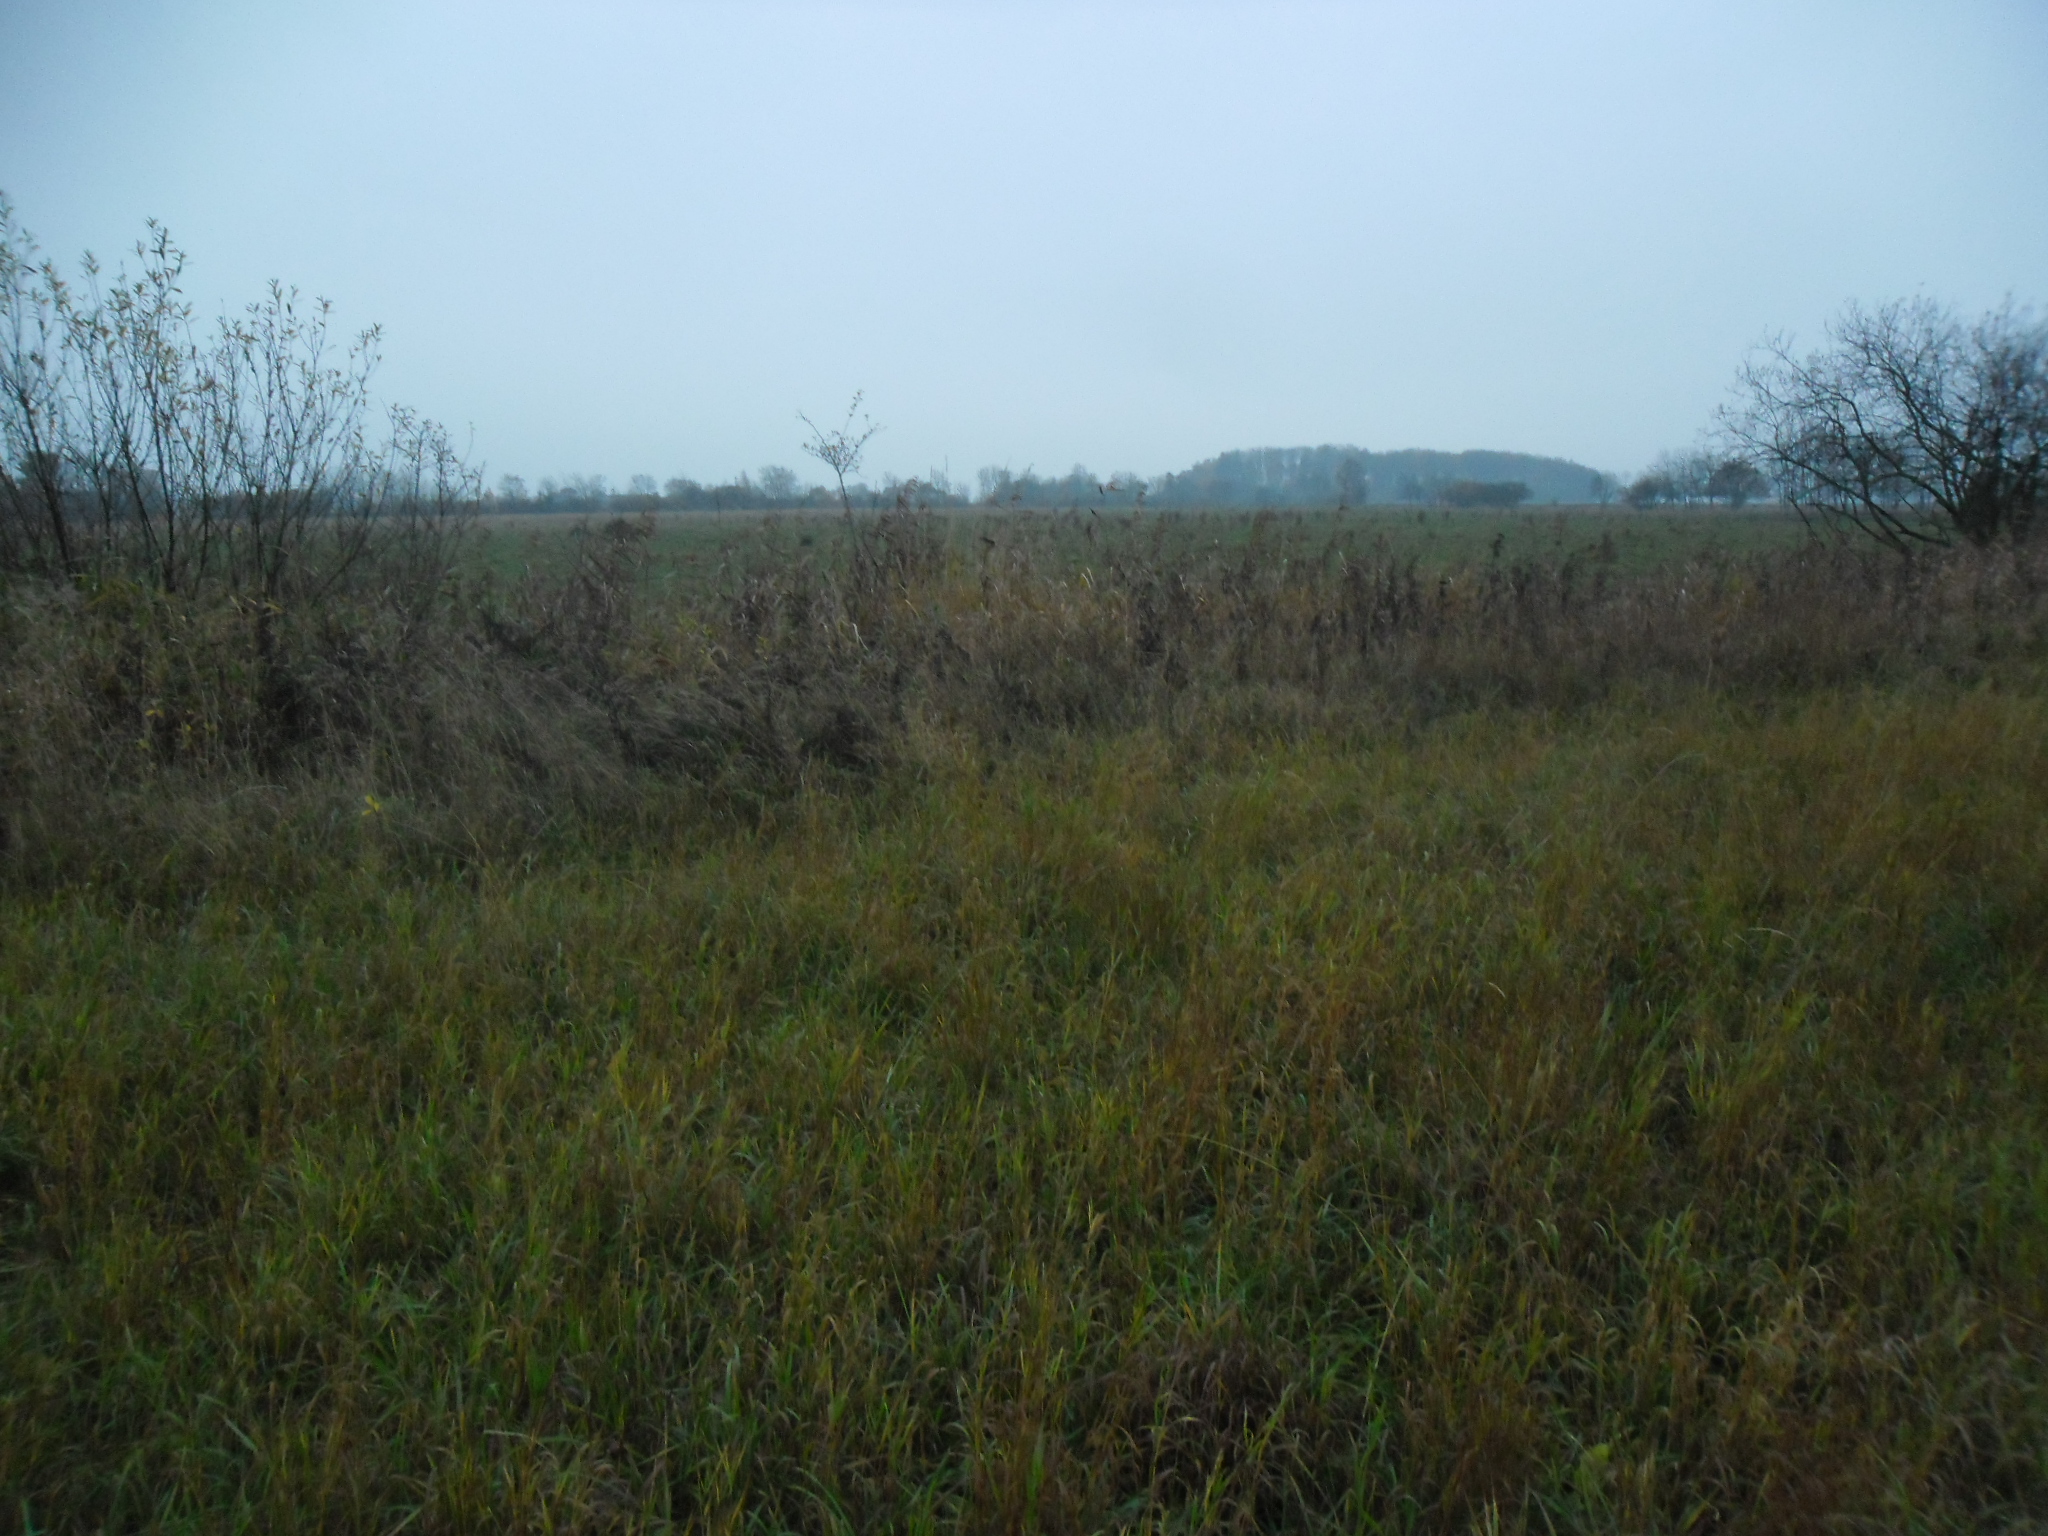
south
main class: Grassland
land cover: Grassland without tree/shrub cover
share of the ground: > 75 %
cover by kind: herbaceous plants 100 %
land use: Agriculture (excluding fallow land and kitchen gardens)
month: November
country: SE
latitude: 56.2129
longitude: 12.7223
